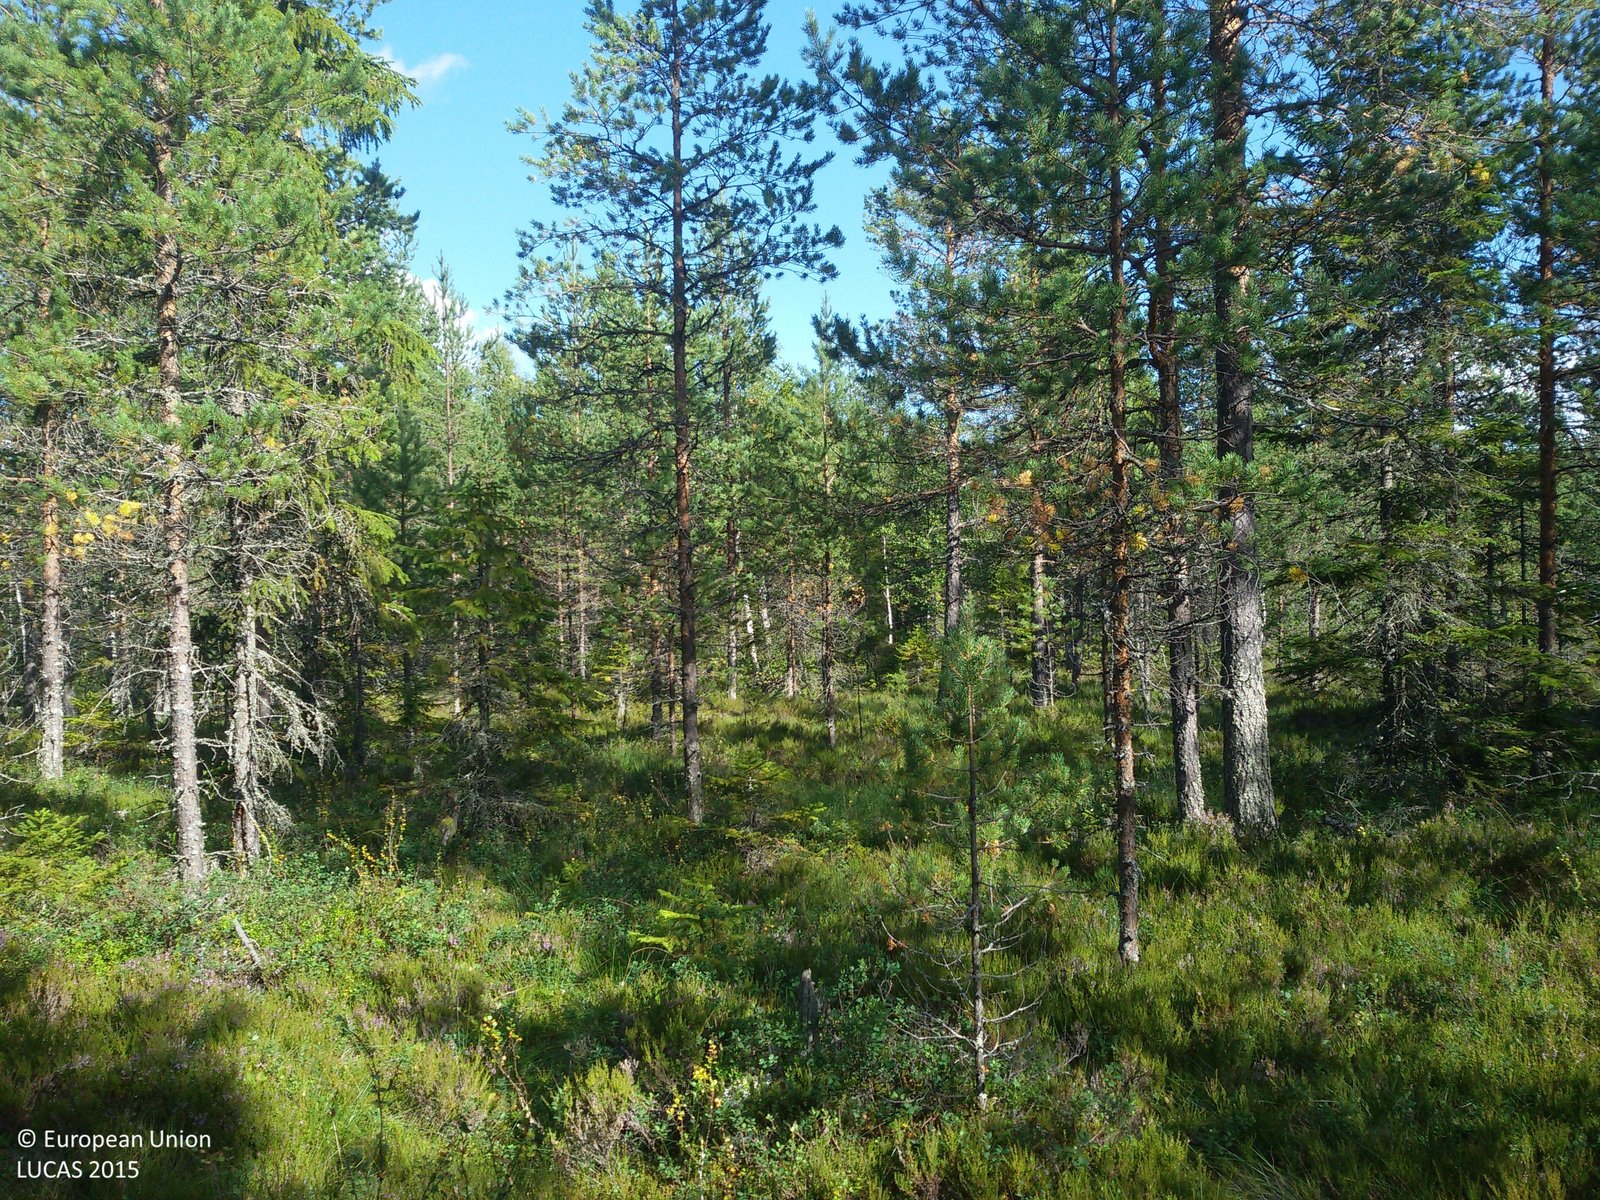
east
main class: Woodland
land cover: Pine dominated coniferous woodland
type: boreal forest
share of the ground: 50 - 75 %
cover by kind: coniferous forest trees 50 %, herbaceous plants 40 %, lichens and mosses 10 %
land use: Forestry
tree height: > 5 m
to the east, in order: Pine dominated coniferous woodland; Spruce dominated mixed woodland; Rivers and streams; Spruce dominated mixed woodland; Rivers and streams; Broadleaved woodland
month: August
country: SE
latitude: 60.9224
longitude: 15.9443
